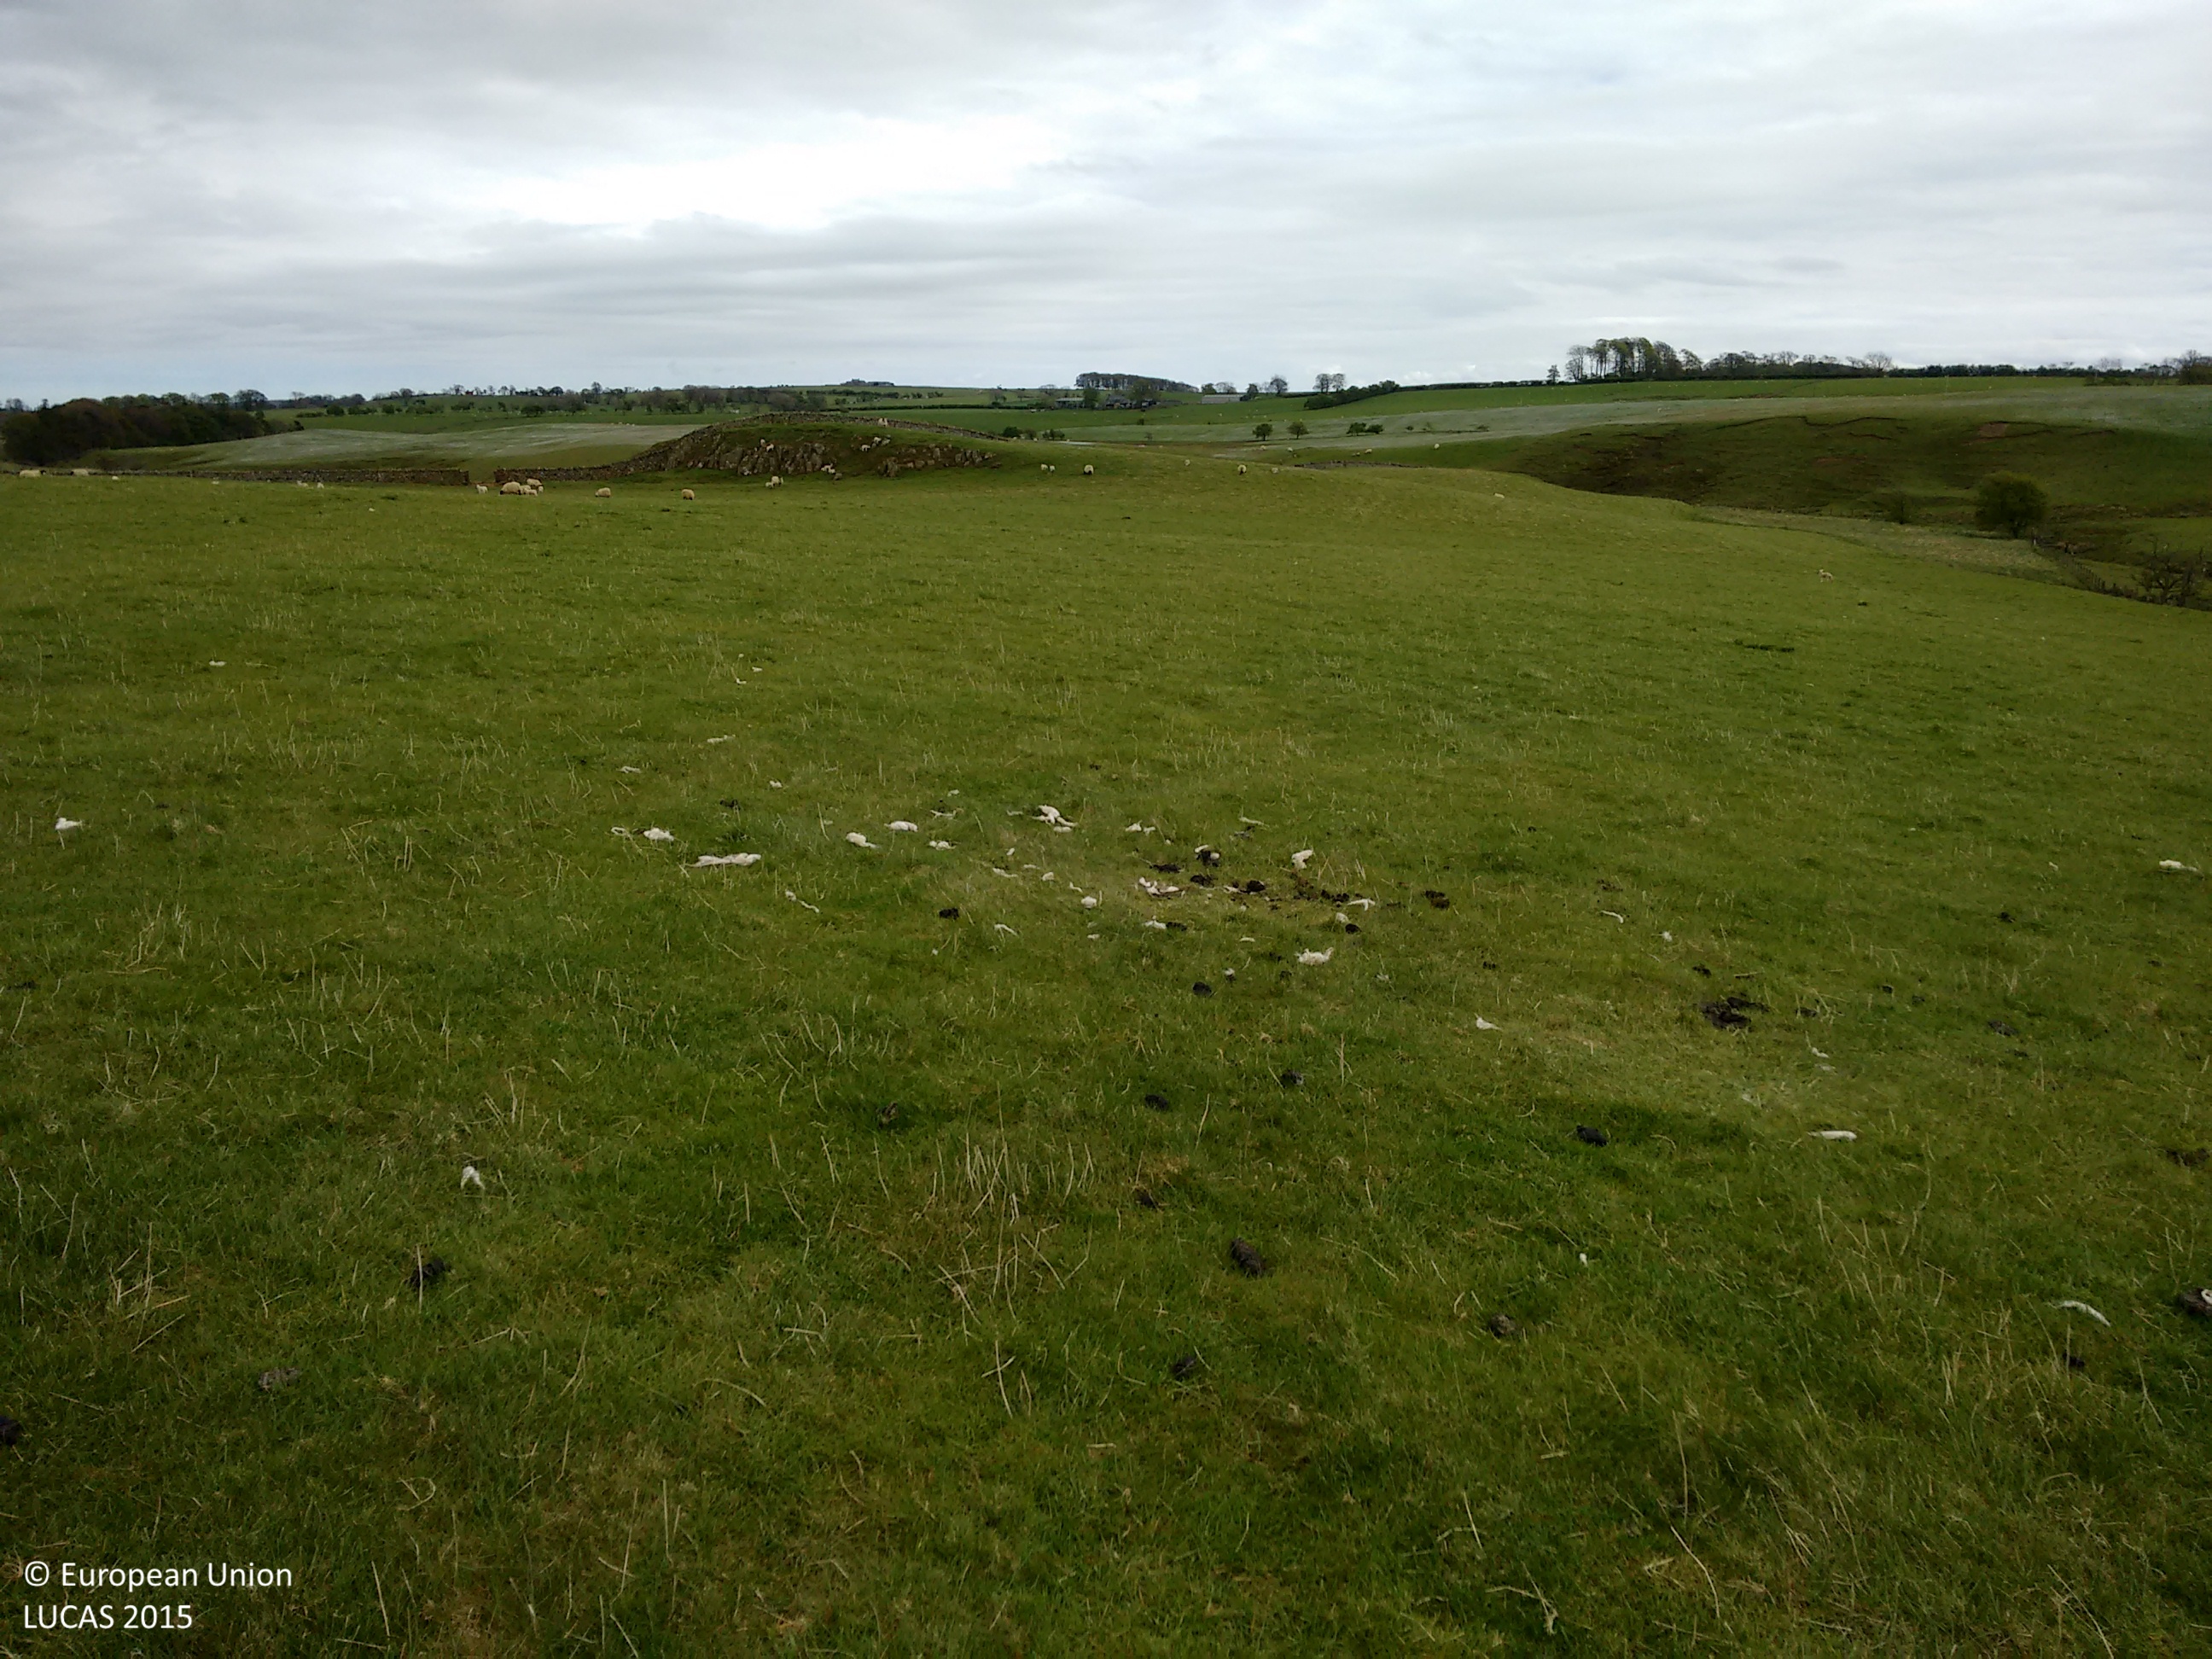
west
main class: Grassland
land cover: Grassland without tree/shrub cover
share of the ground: > 75 %
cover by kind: herbaceous plants 100 %
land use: Agriculture (excluding fallow land and kitchen gardens)
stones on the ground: < 10 %
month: May
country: GB
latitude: 55.1289
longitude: -2.0209
